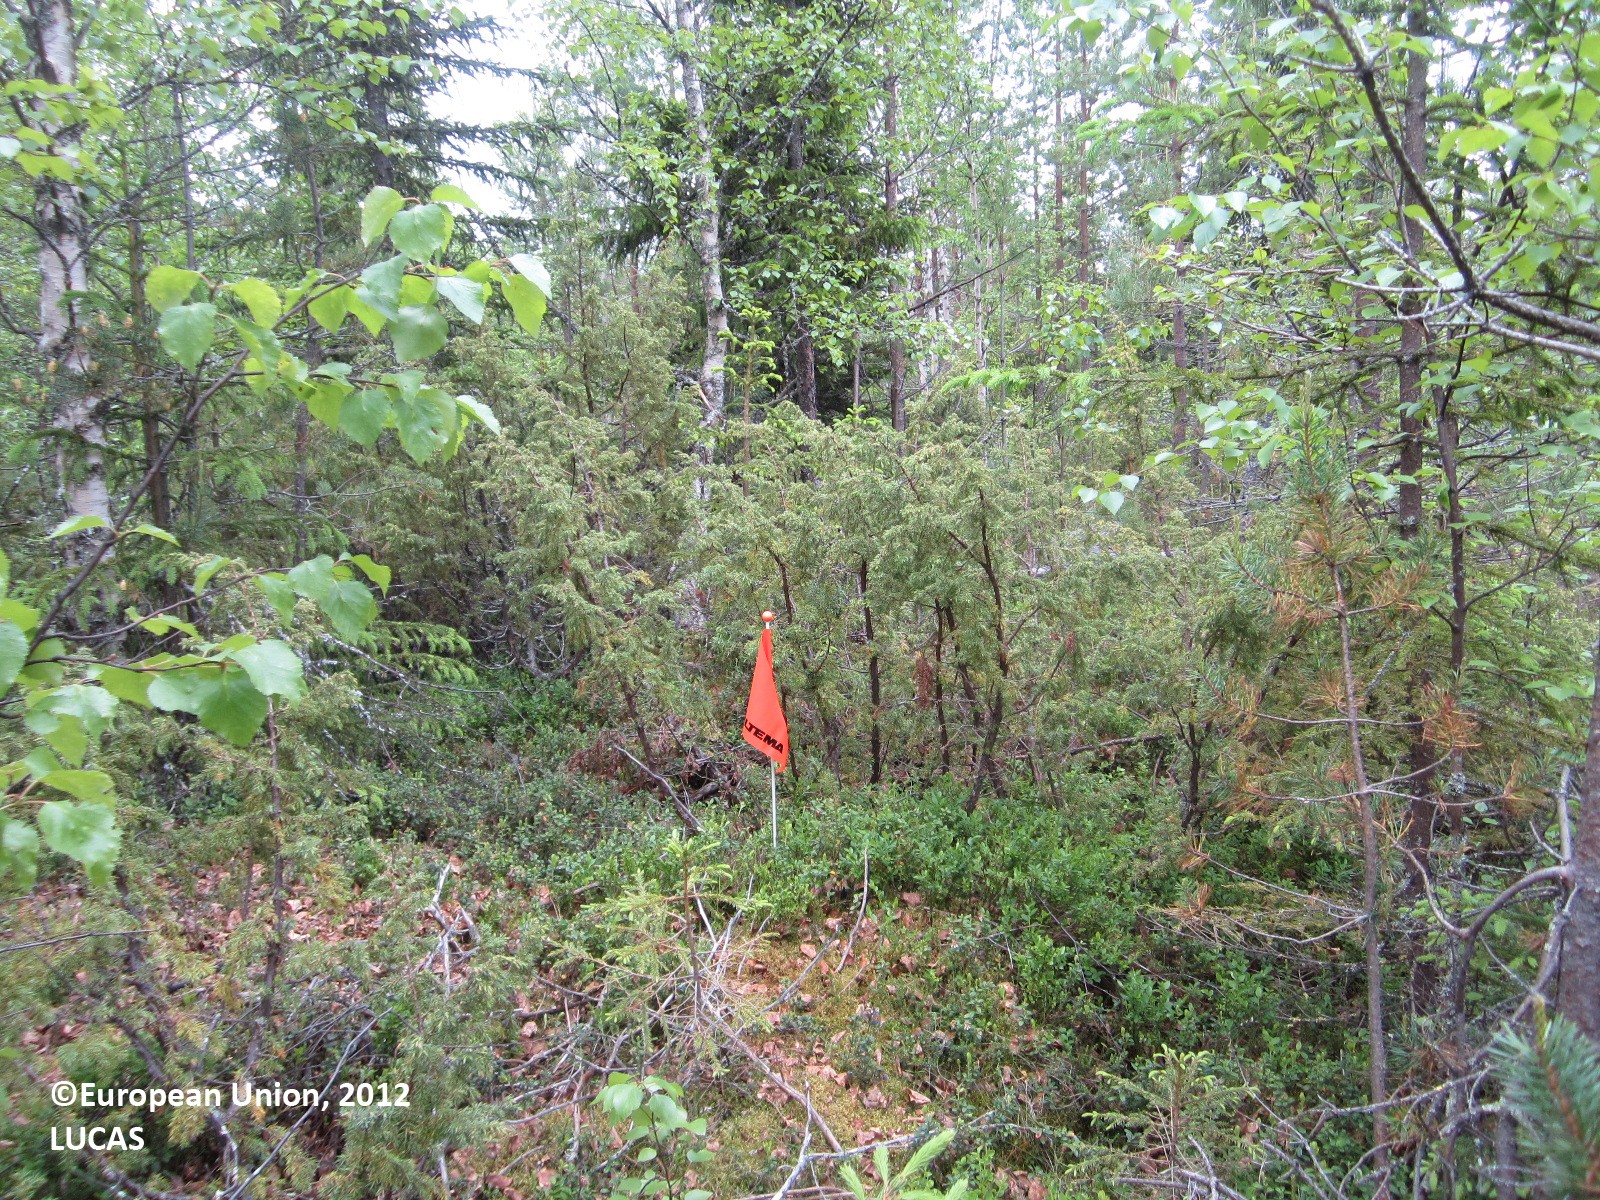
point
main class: Woodland
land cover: Pine dominated mixed woodland
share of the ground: 50 - 75 %
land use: Forestry
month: June
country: FI
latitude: 64.6646
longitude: 29.6755
